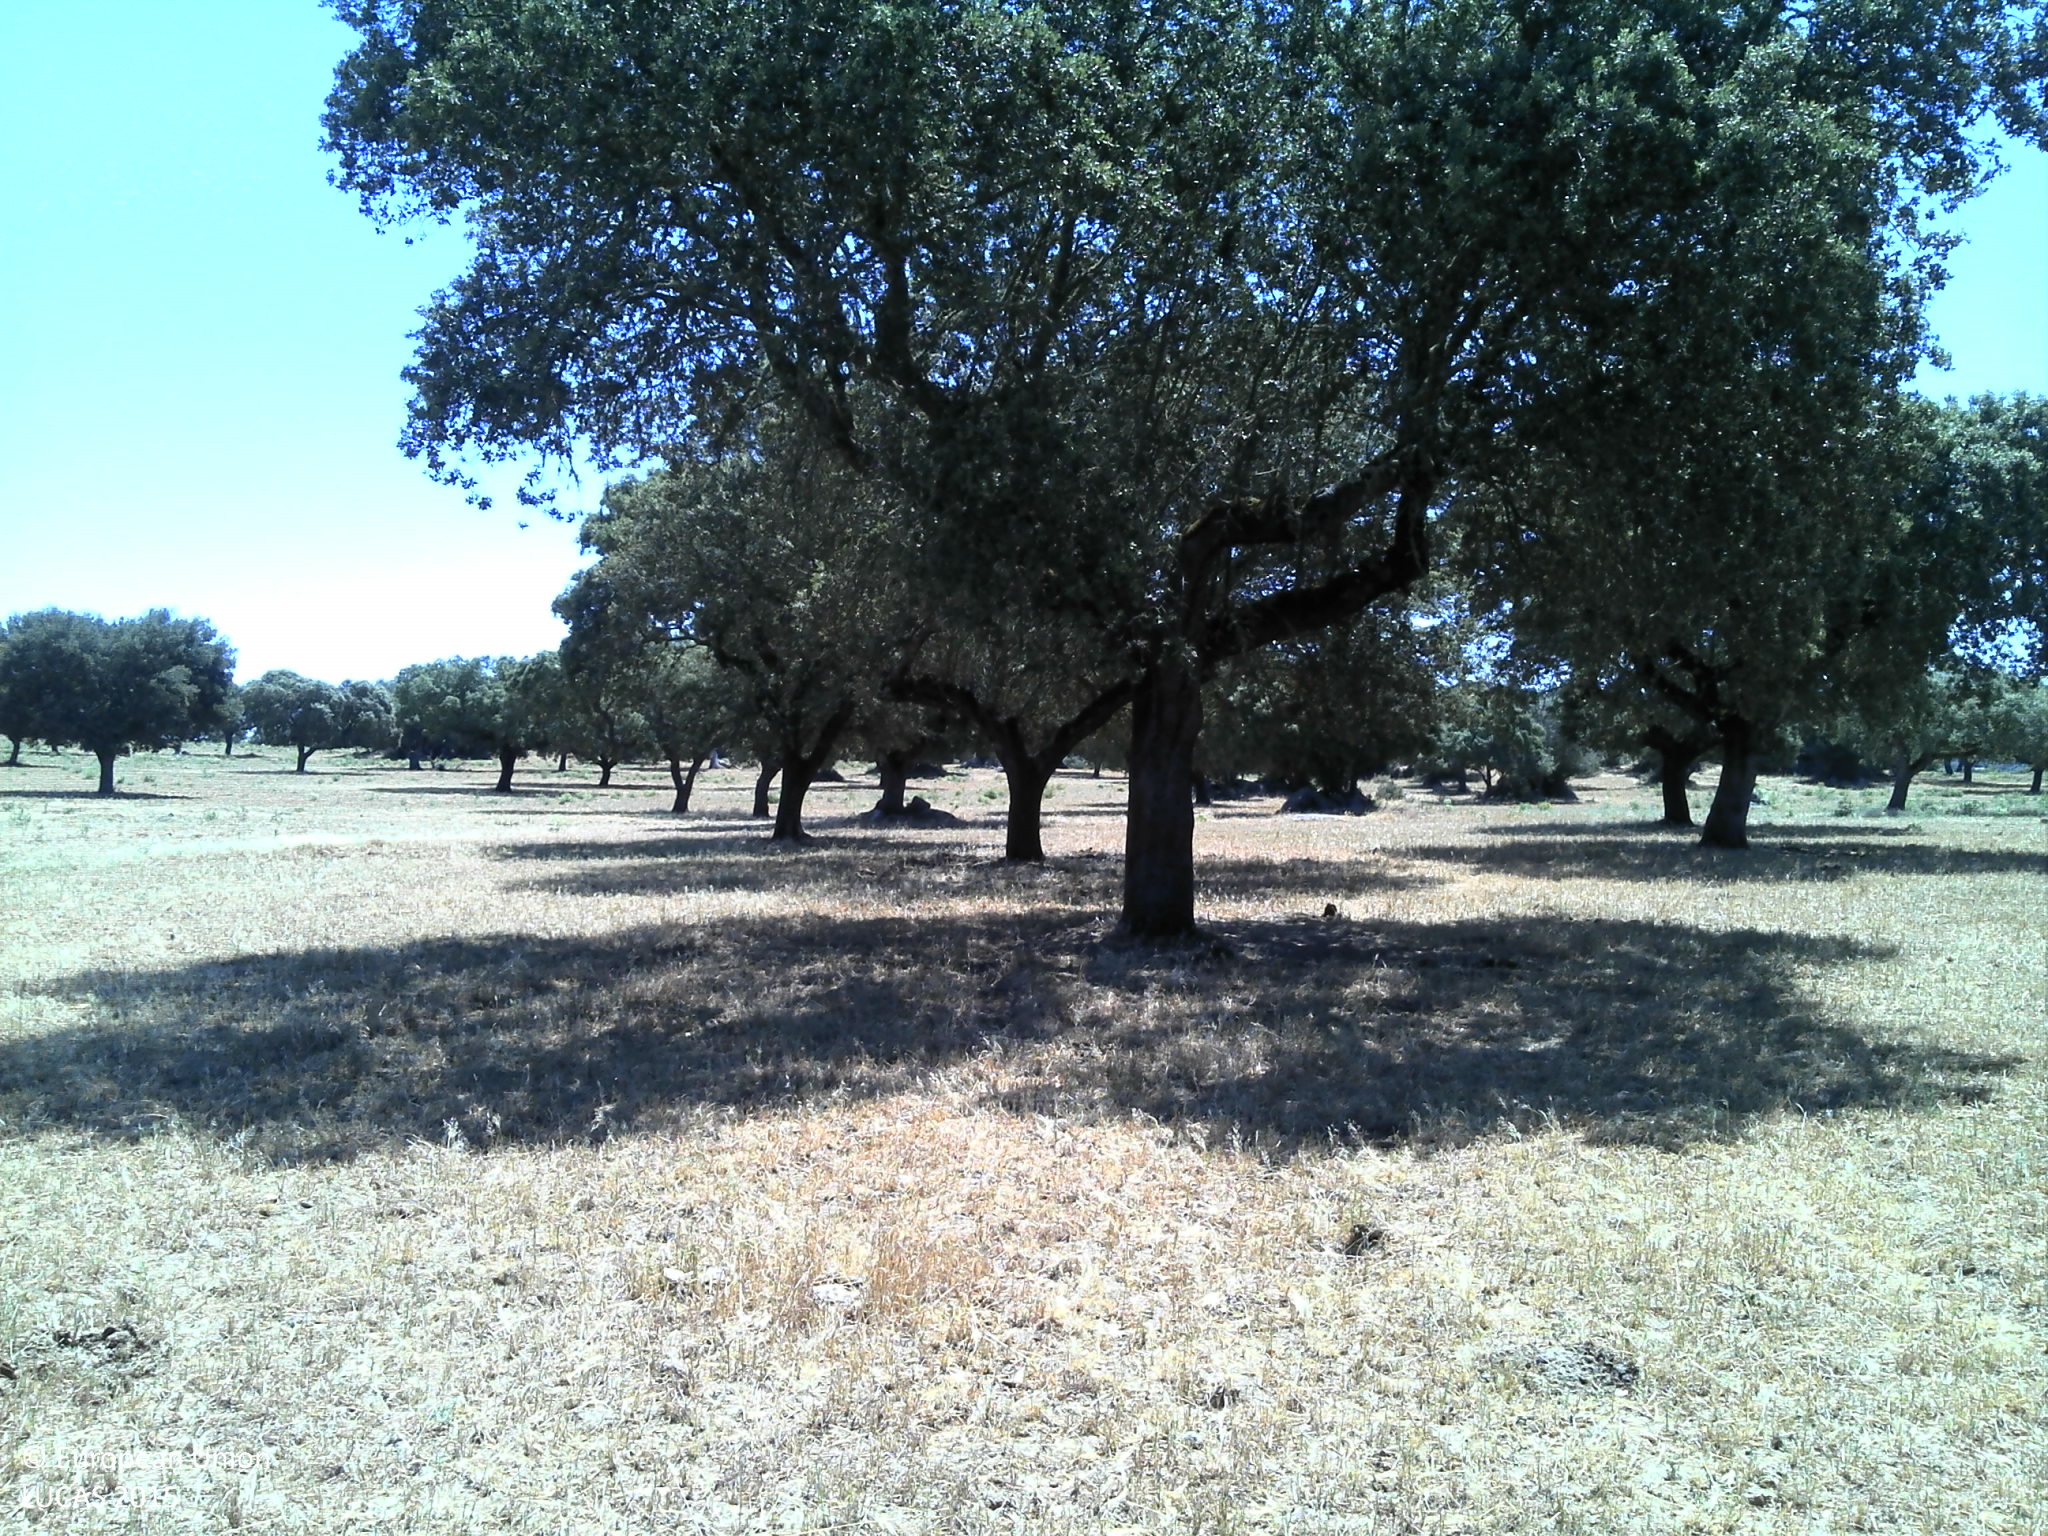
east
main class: Woodland
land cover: Broadleaved woodland
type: broadleaved evergreen forest
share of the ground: 25 - 50 %
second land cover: Grassland without tree/shrub cover
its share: 25 - 50 %
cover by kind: unconsolidated bare surface 50 %, broadleaved forest trees 25 %, herbaceous plants 25 %
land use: Forestry
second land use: Agriculture (excluding fallow land and kitchen gardens)
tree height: > 5 m
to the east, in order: Broadleaved woodland; Grassland without tree/shrub cover; Tracks; Broadleaved woodland
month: June
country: PT
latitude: 38.7901
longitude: -7.8053
